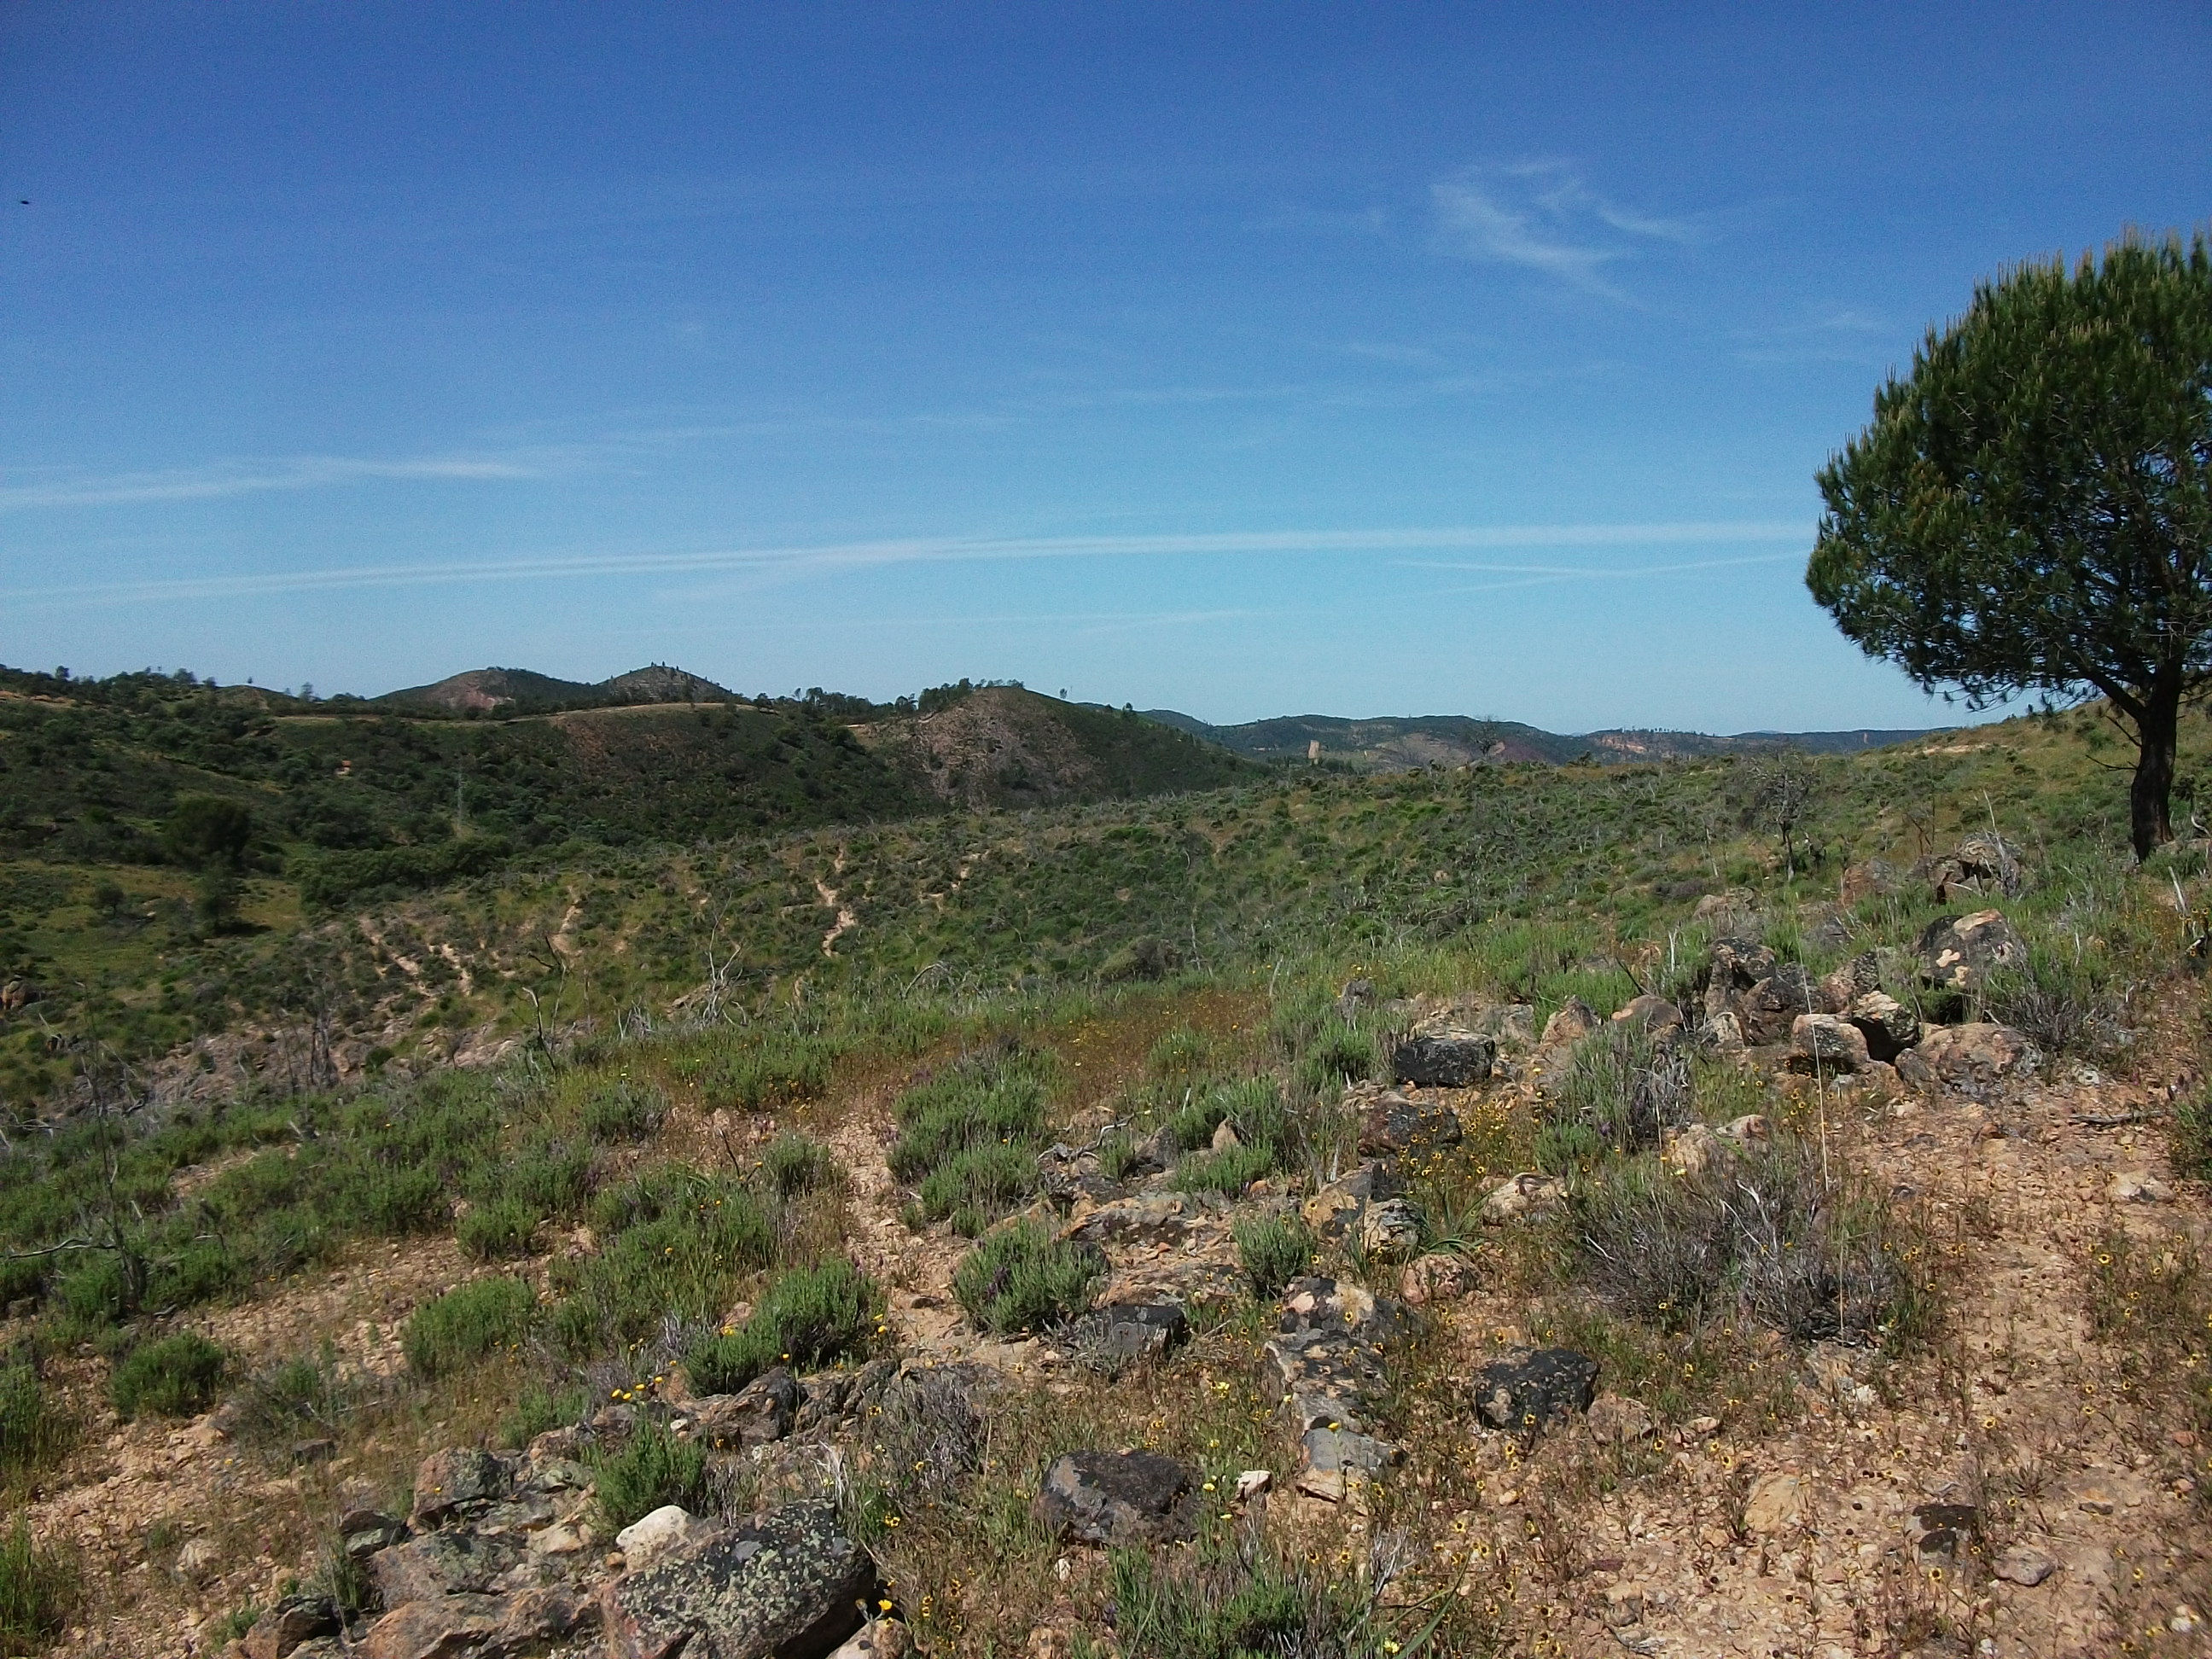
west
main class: Woodland
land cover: Pine dominated coniferous woodland
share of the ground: 25 - 50 %
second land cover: Shrubland without tree cover
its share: 50 - 75 %
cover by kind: shrubs 65 %, coniferous forest trees 25 %, unconsolidated bare surface 10 %
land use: Forestry
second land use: Agriculture (excluding fallow land and kitchen gardens)
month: April
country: ES
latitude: 37.7677
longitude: -6.6278
